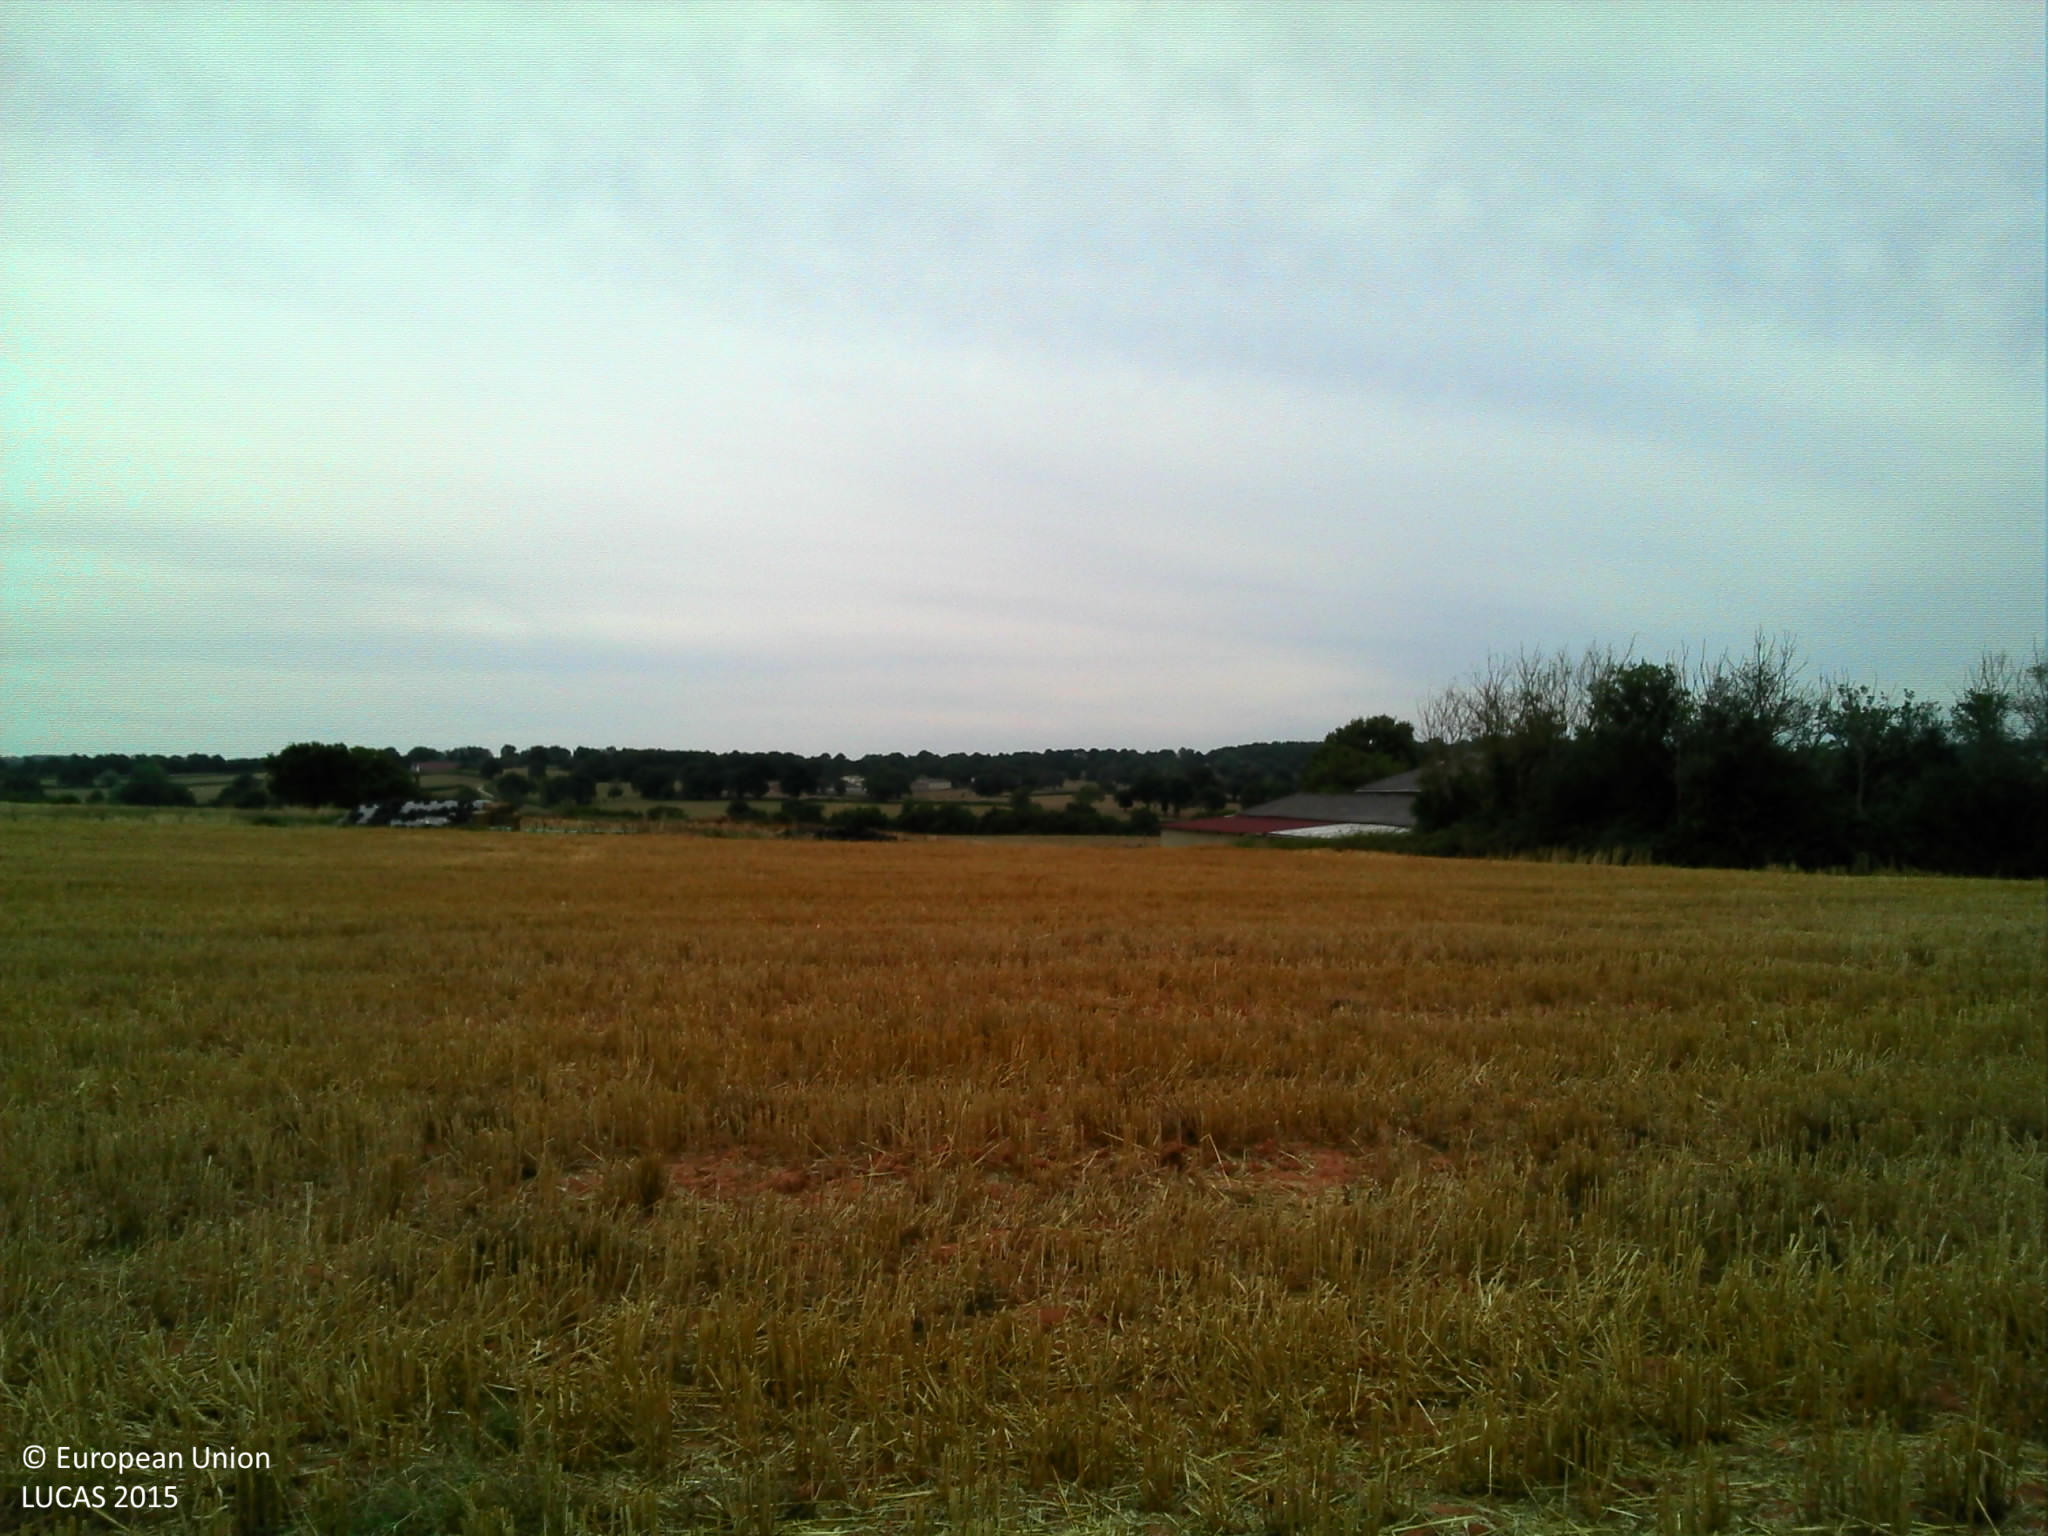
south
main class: Cropland
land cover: Common wheat
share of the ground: > 75 %
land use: Agriculture (excluding fallow land and kitchen gardens)
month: July
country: FR
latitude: 46.5730
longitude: 2.9903
